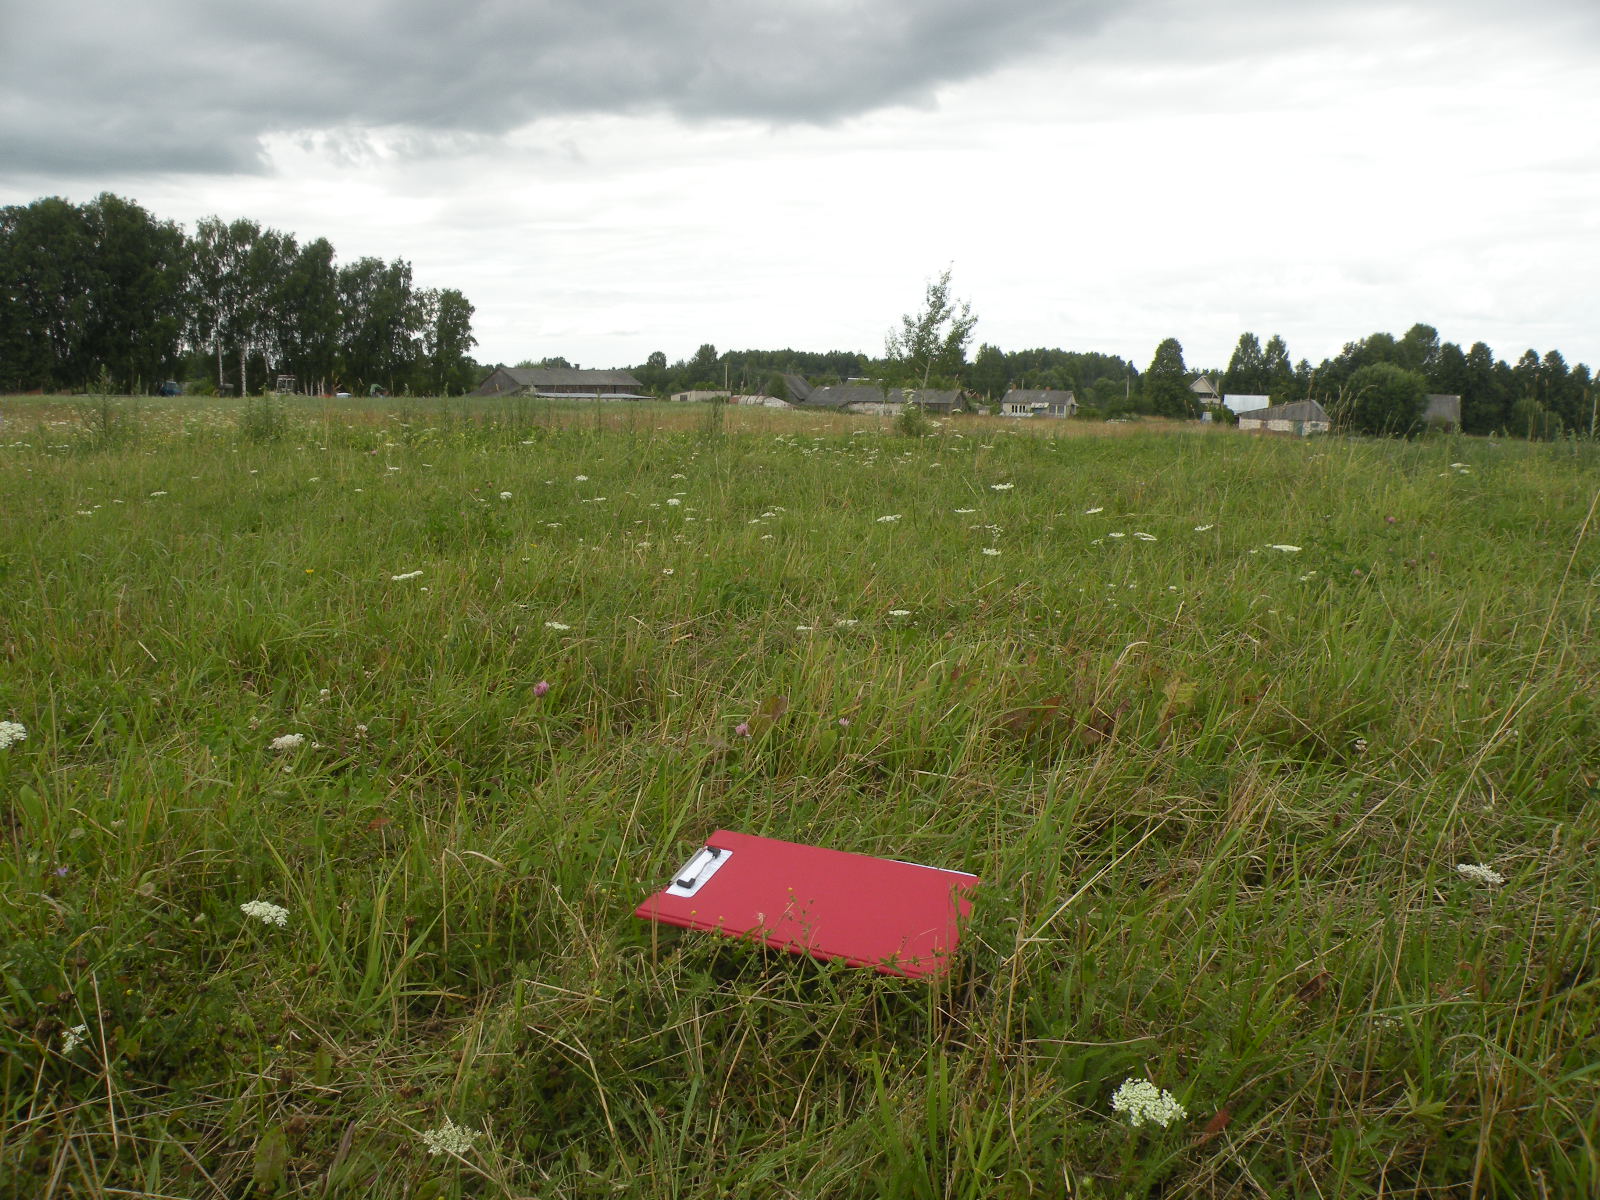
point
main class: Grassland
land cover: Grassland without tree/shrub cover
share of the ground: > 75 %
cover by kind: herbaceous plants 100 %
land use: Agriculture (excluding fallow land and kitchen gardens)
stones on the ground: < 10 %
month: July
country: LV
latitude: 55.8573
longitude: 26.9552
